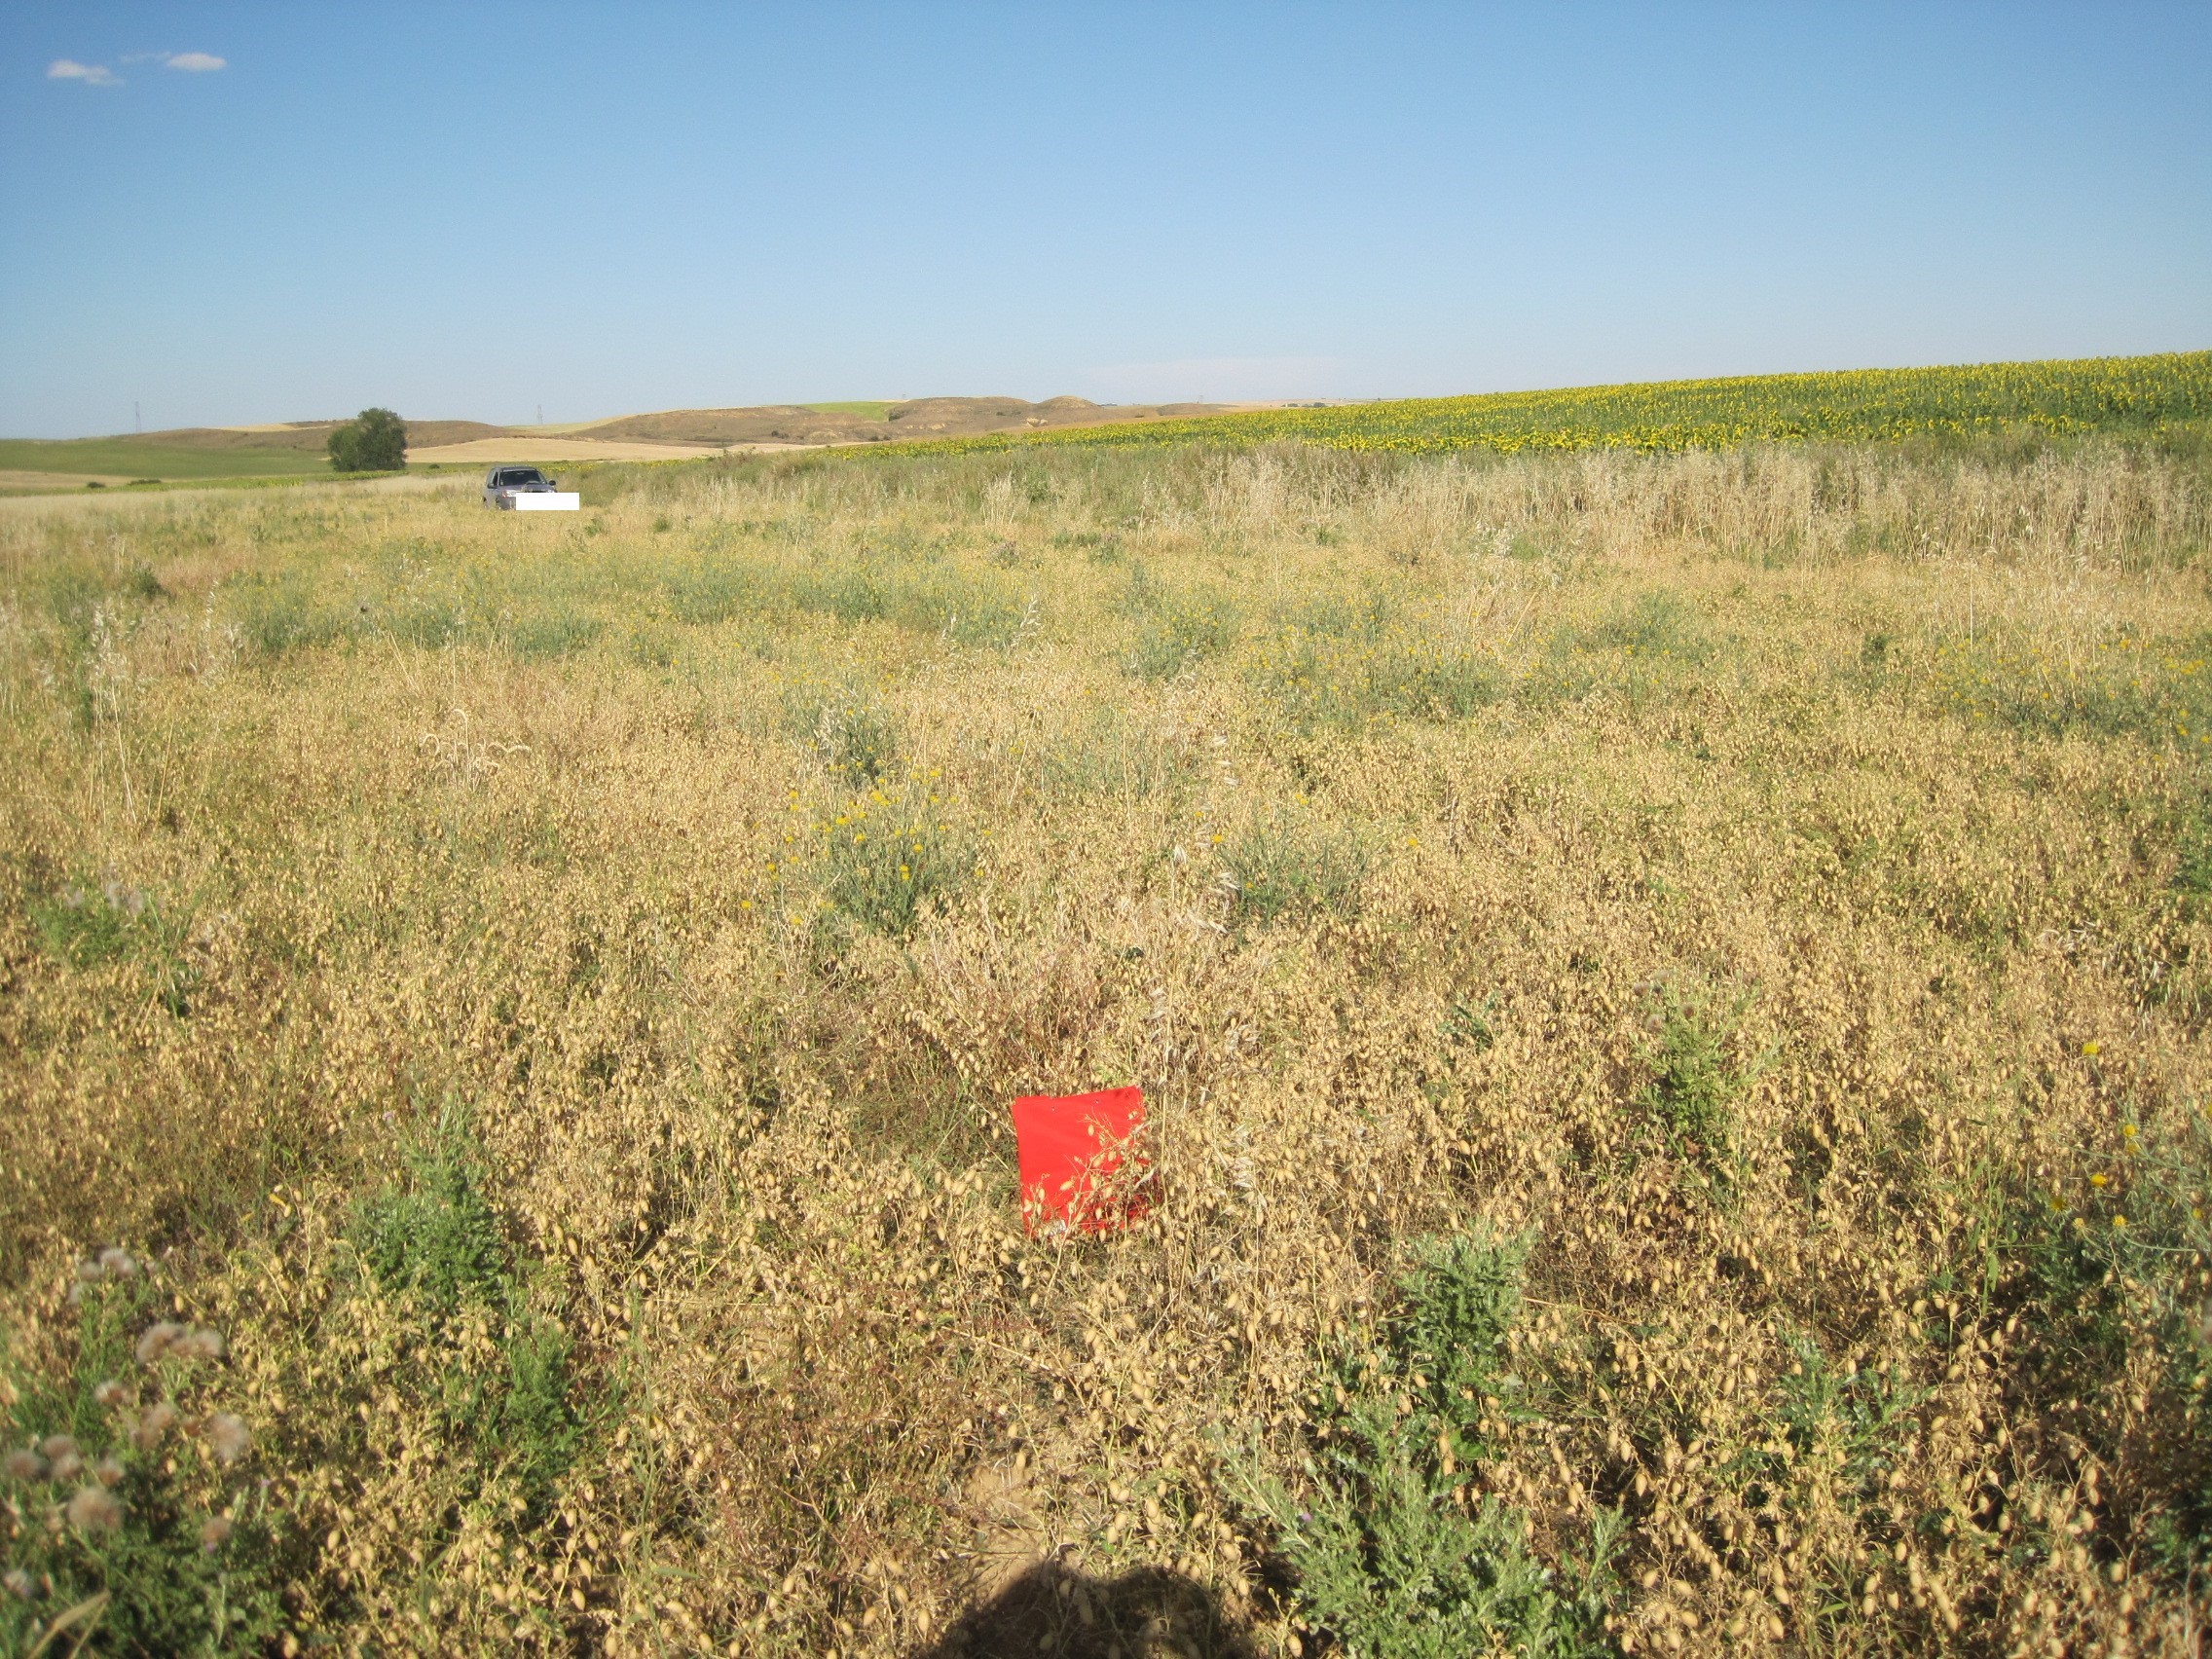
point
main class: Cropland
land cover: Dry pulses
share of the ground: > 75 %
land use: Agriculture (excluding fallow land and kitchen gardens)
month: July
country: ES
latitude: 42.1381
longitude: -5.2202
